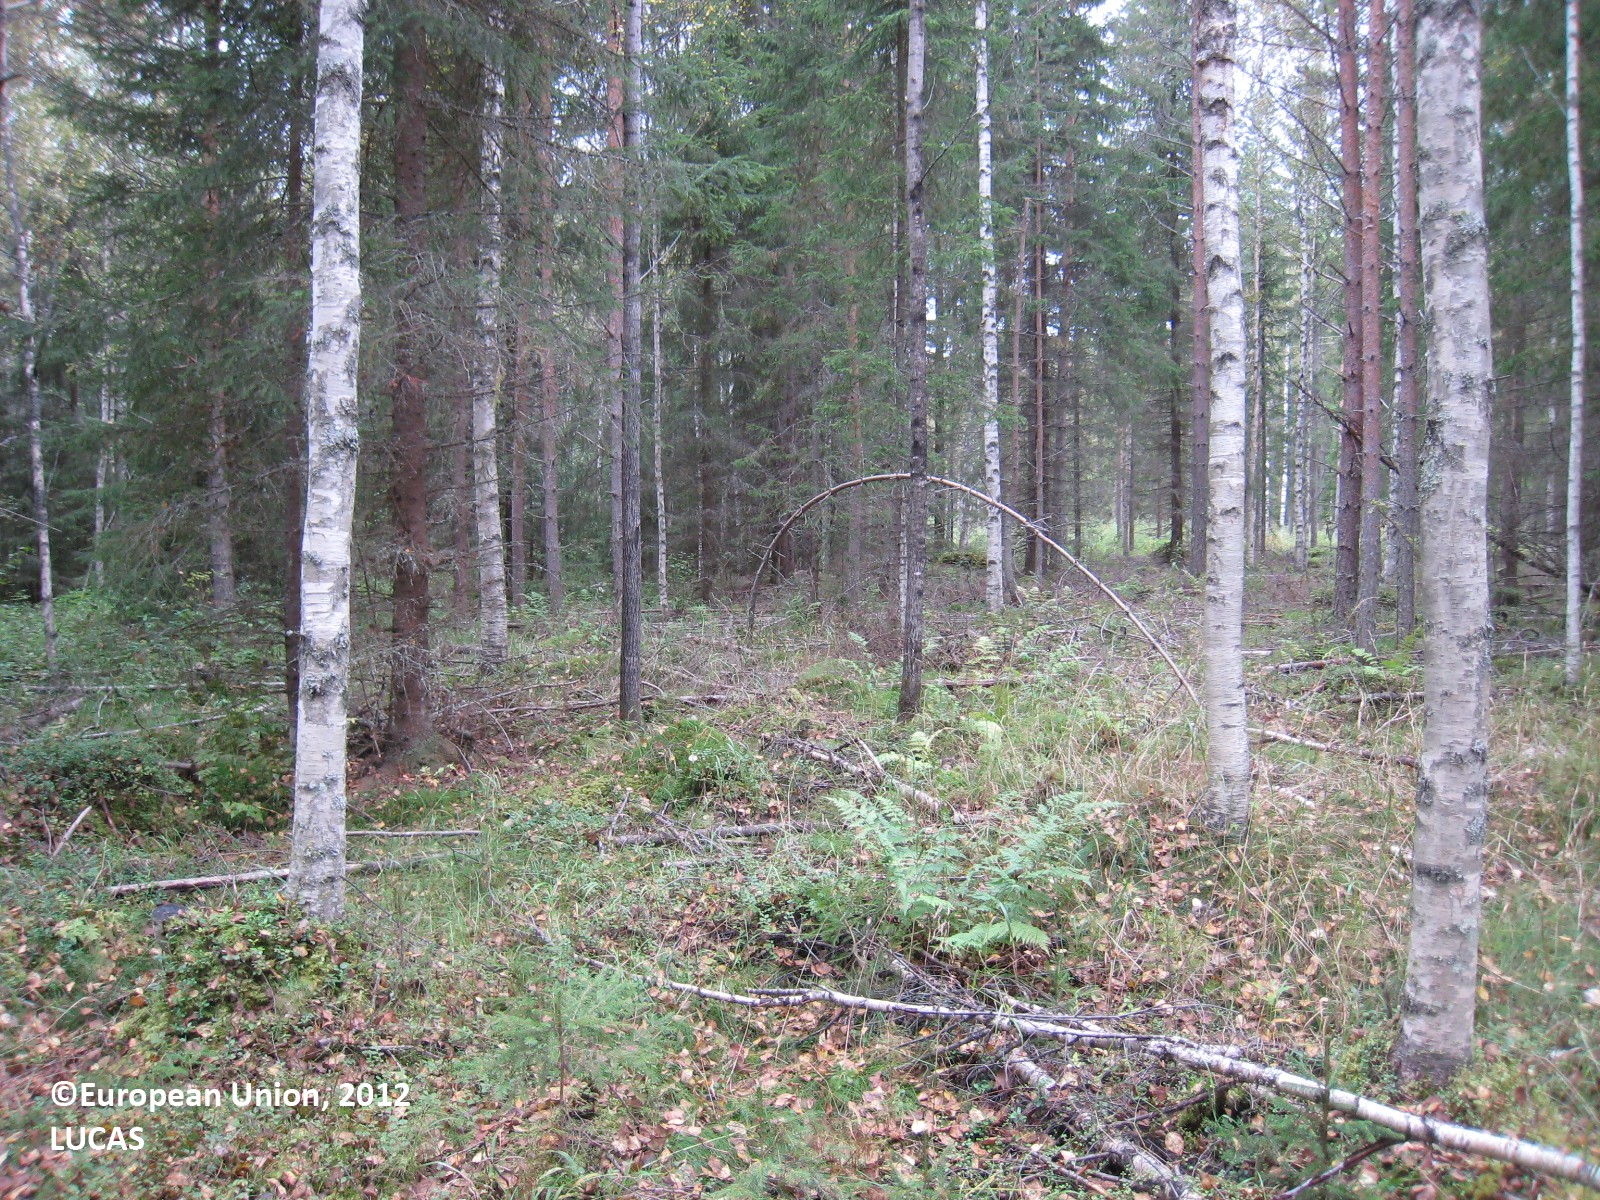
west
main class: Woodland
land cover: Other mixed woodland
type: boreal forest
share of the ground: 50 - 75 %
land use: Forestry
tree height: > 5 m
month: September
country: FI
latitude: 63.1971
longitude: 26.4483
